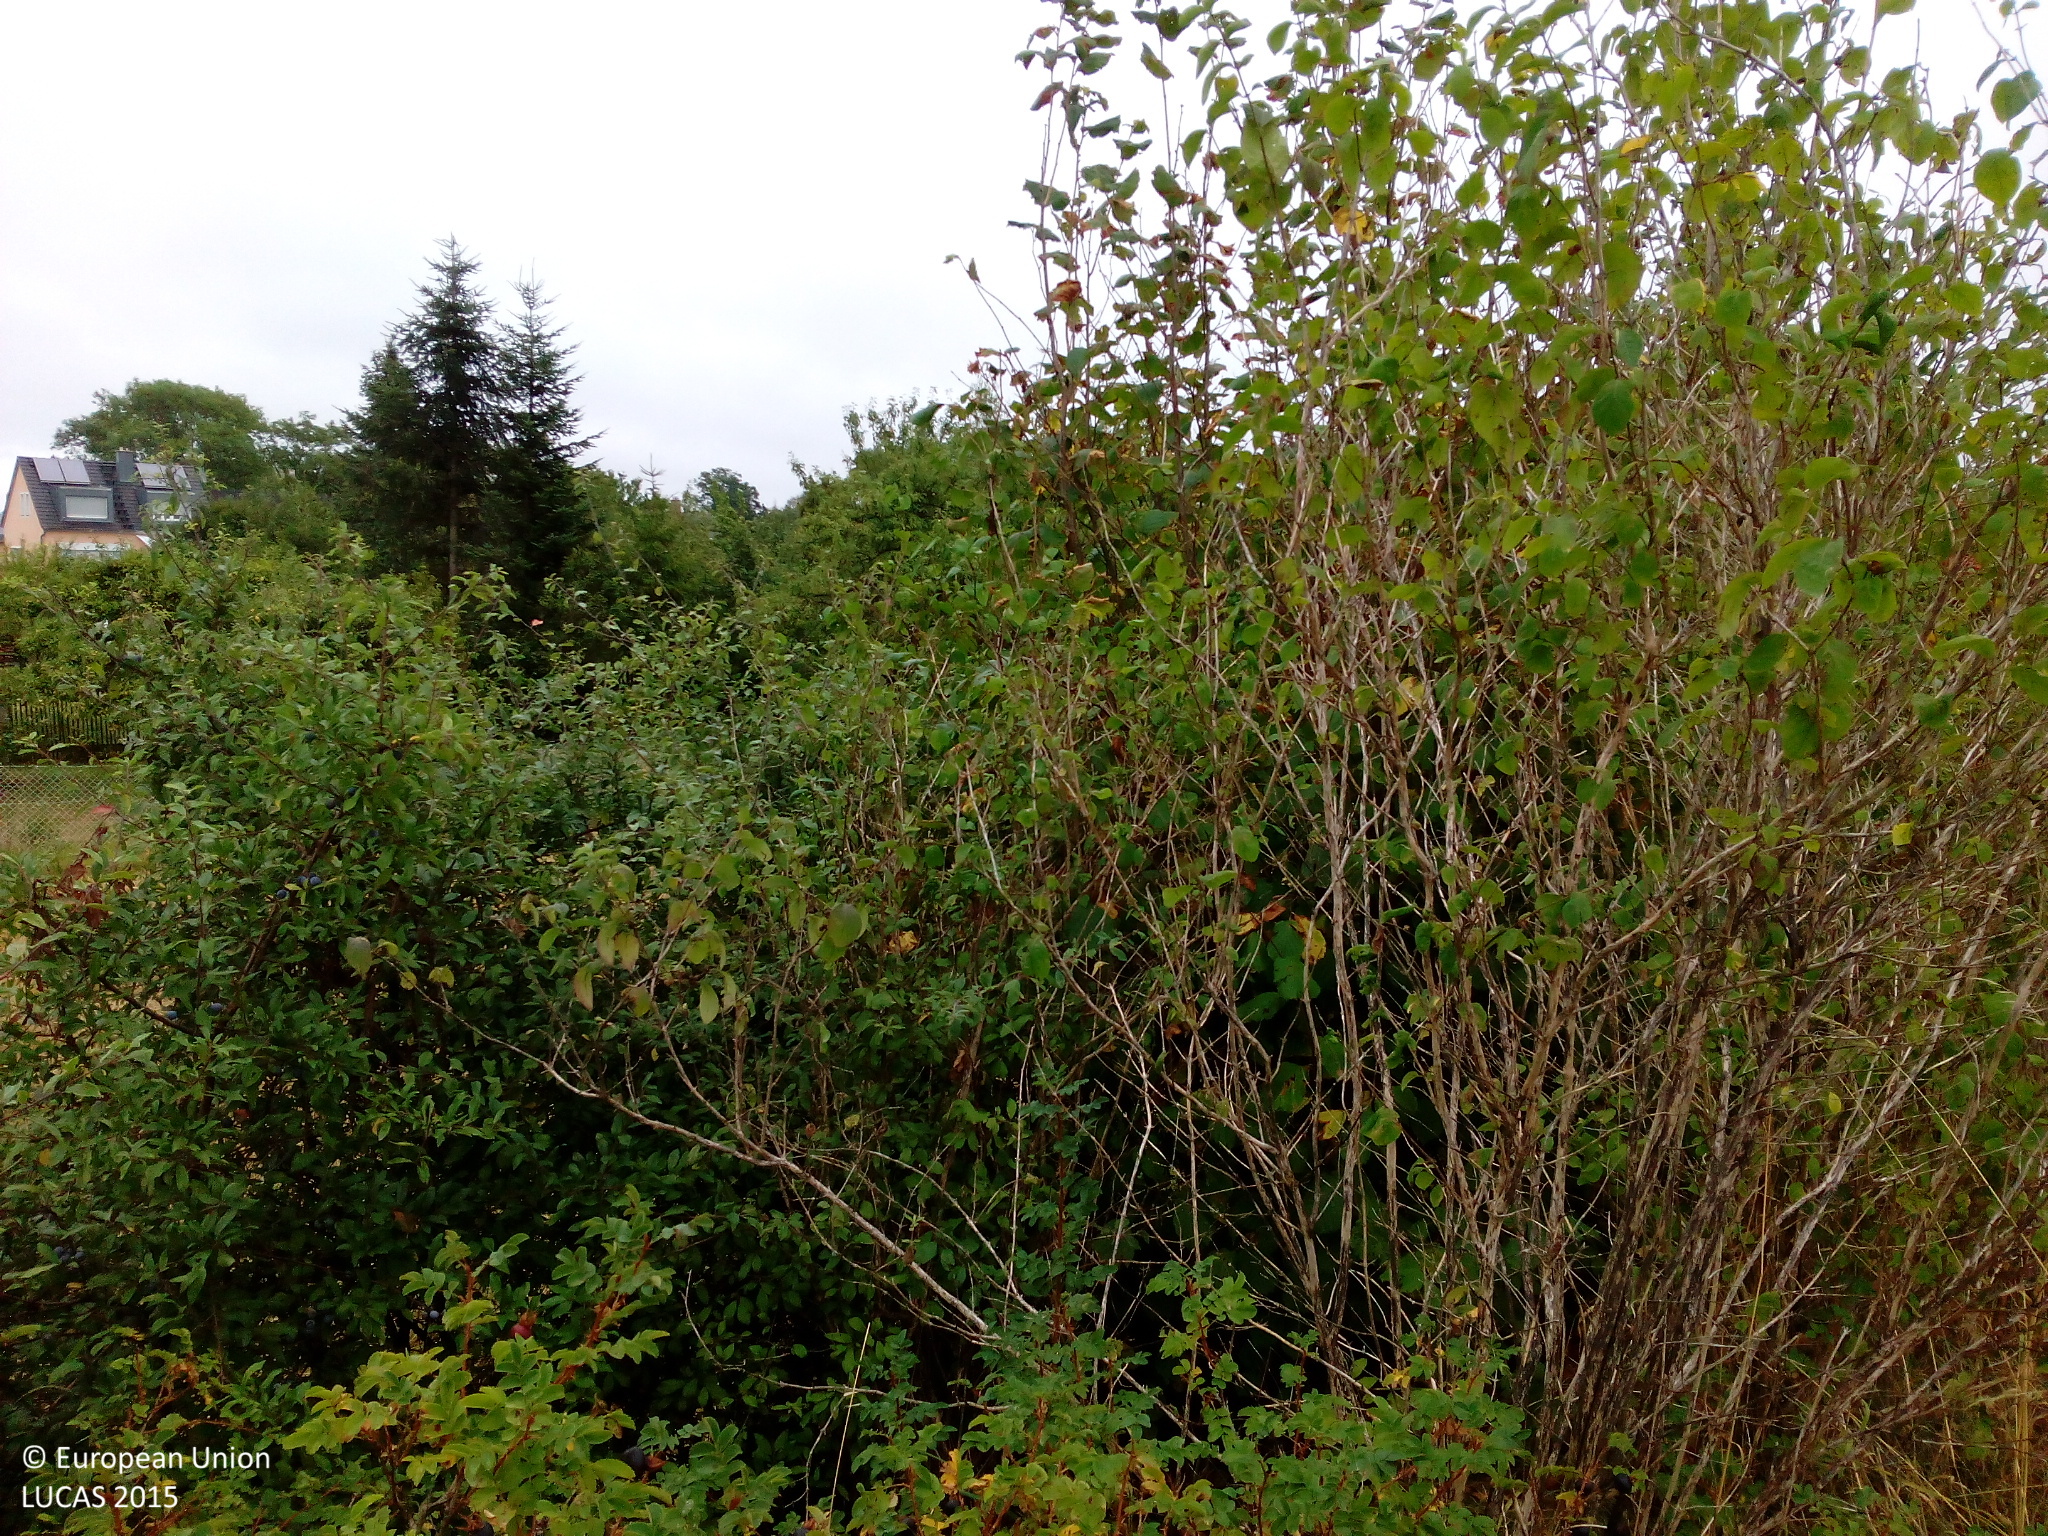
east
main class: Shrubland
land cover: Shrubland with sparse tree cover
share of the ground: > 75 %
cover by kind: shrubs 95 %, broadleaved forest trees 5 %
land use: Road transport
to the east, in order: Shrubland with sparse tree cover; Grass margins; Barley; Artificial constructions in urban areas; Grassland without tree/shrub cover
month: August
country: DE
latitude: 50.0933
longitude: 12.0824
